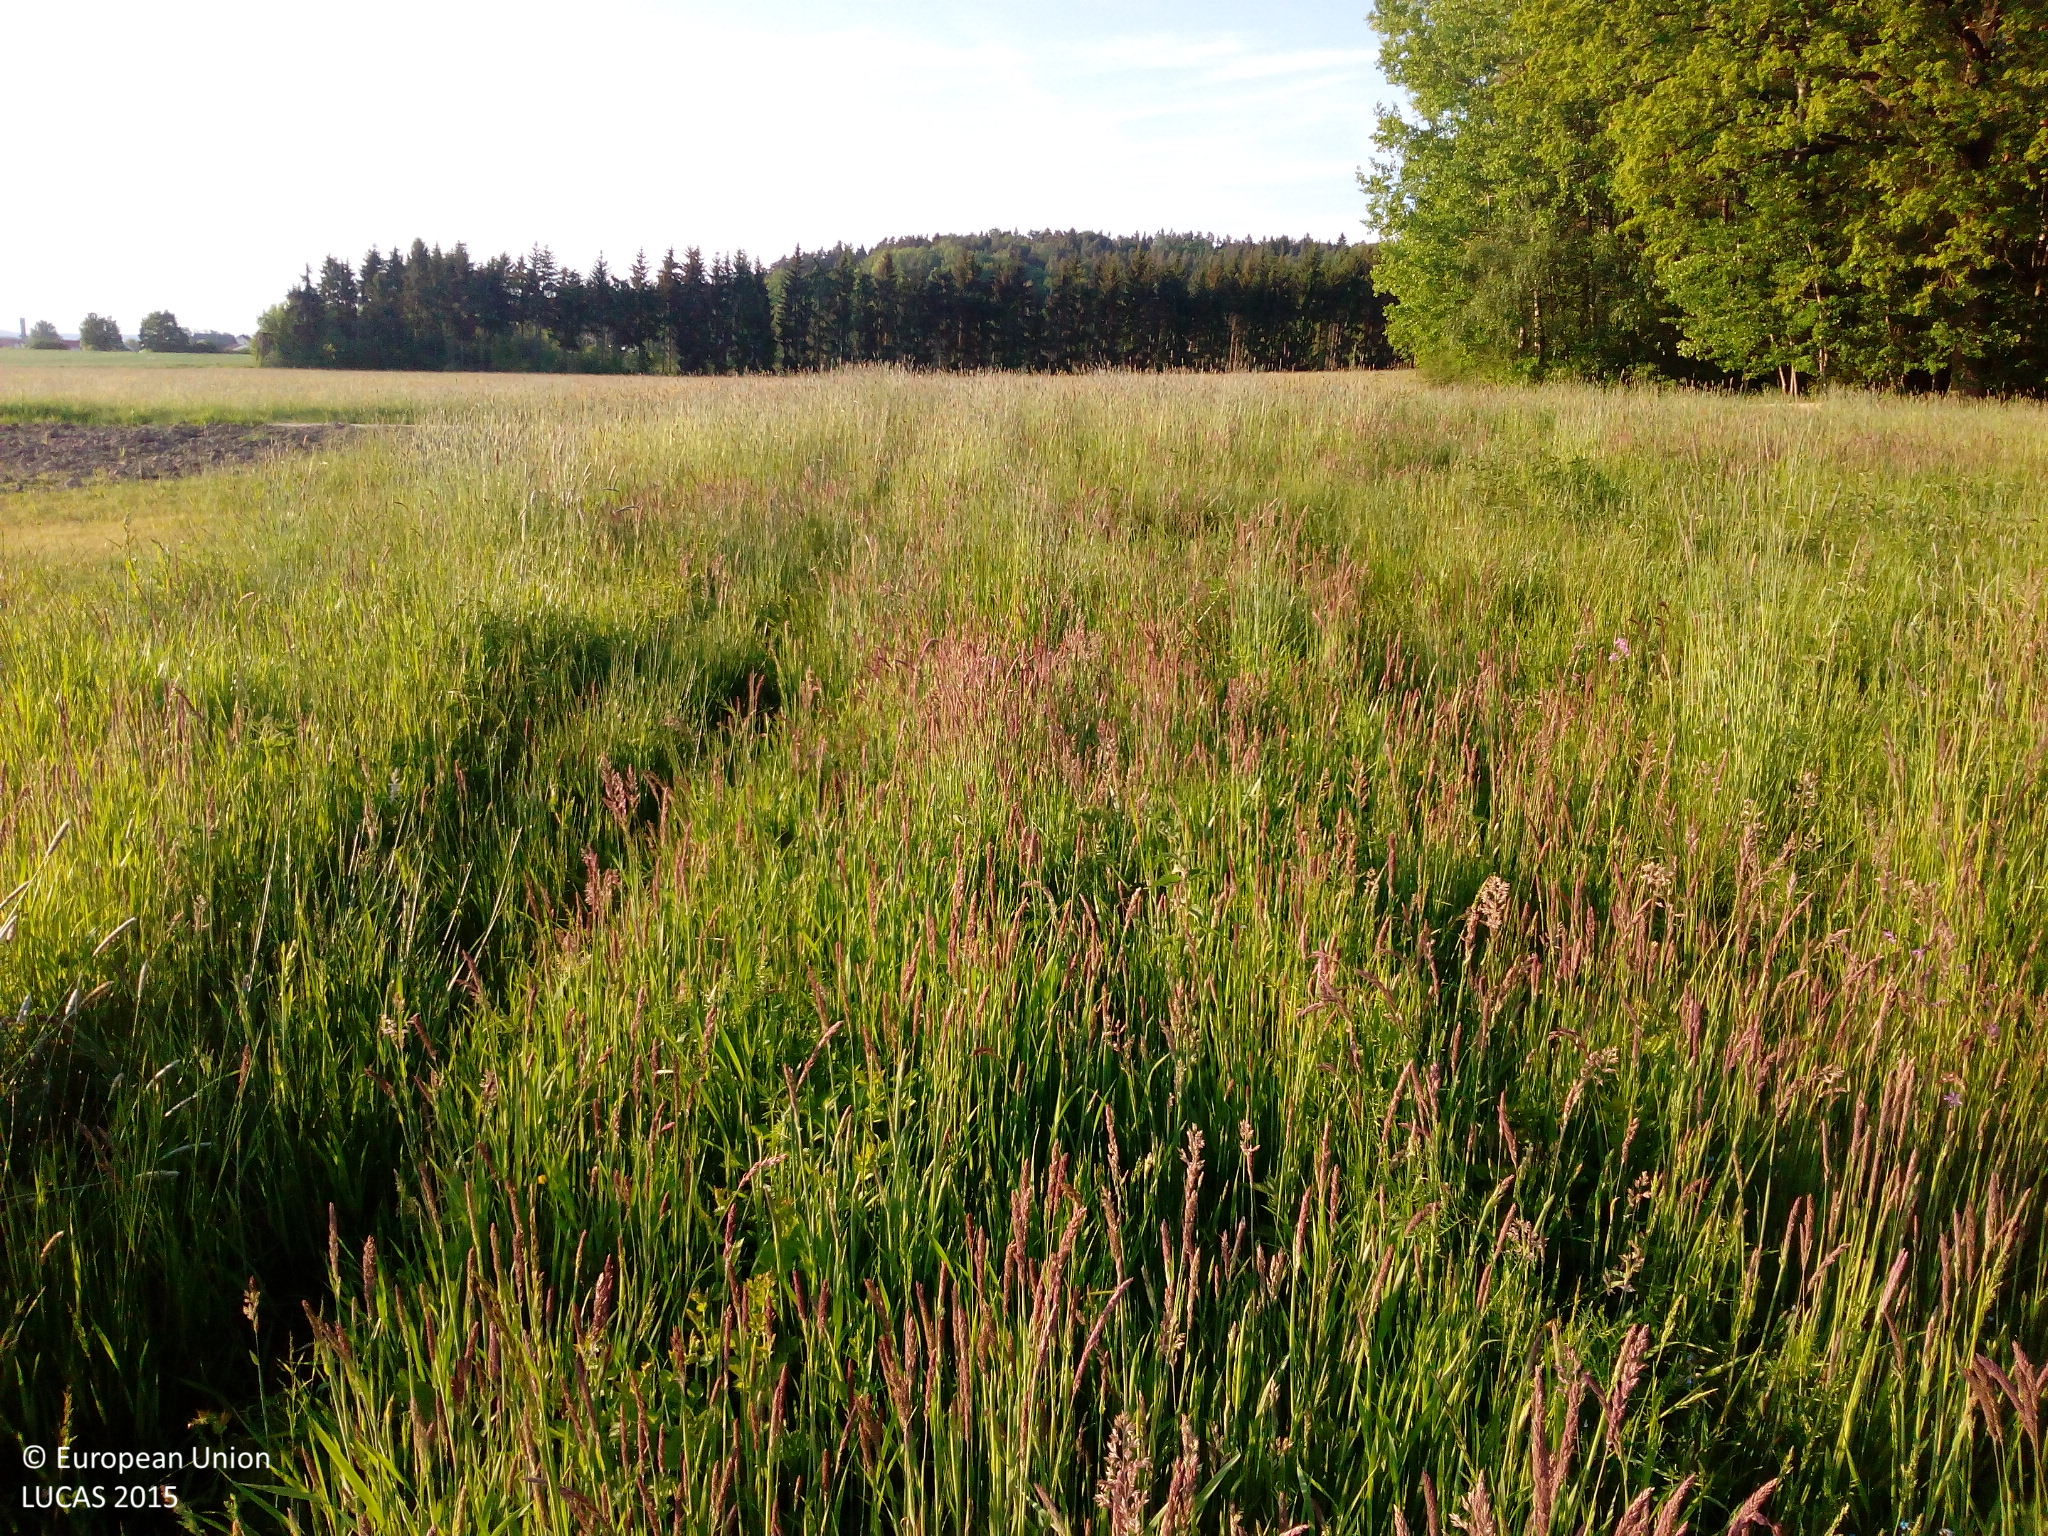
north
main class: Grassland
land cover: Grassland without tree/shrub cover
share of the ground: > 75 %
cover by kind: herbaceous plants 95 %, unconsolidated bare surface 5 %
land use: Agriculture (excluding fallow land and kitchen gardens)
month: May
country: DE
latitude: 49.2214
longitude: 11.4686
